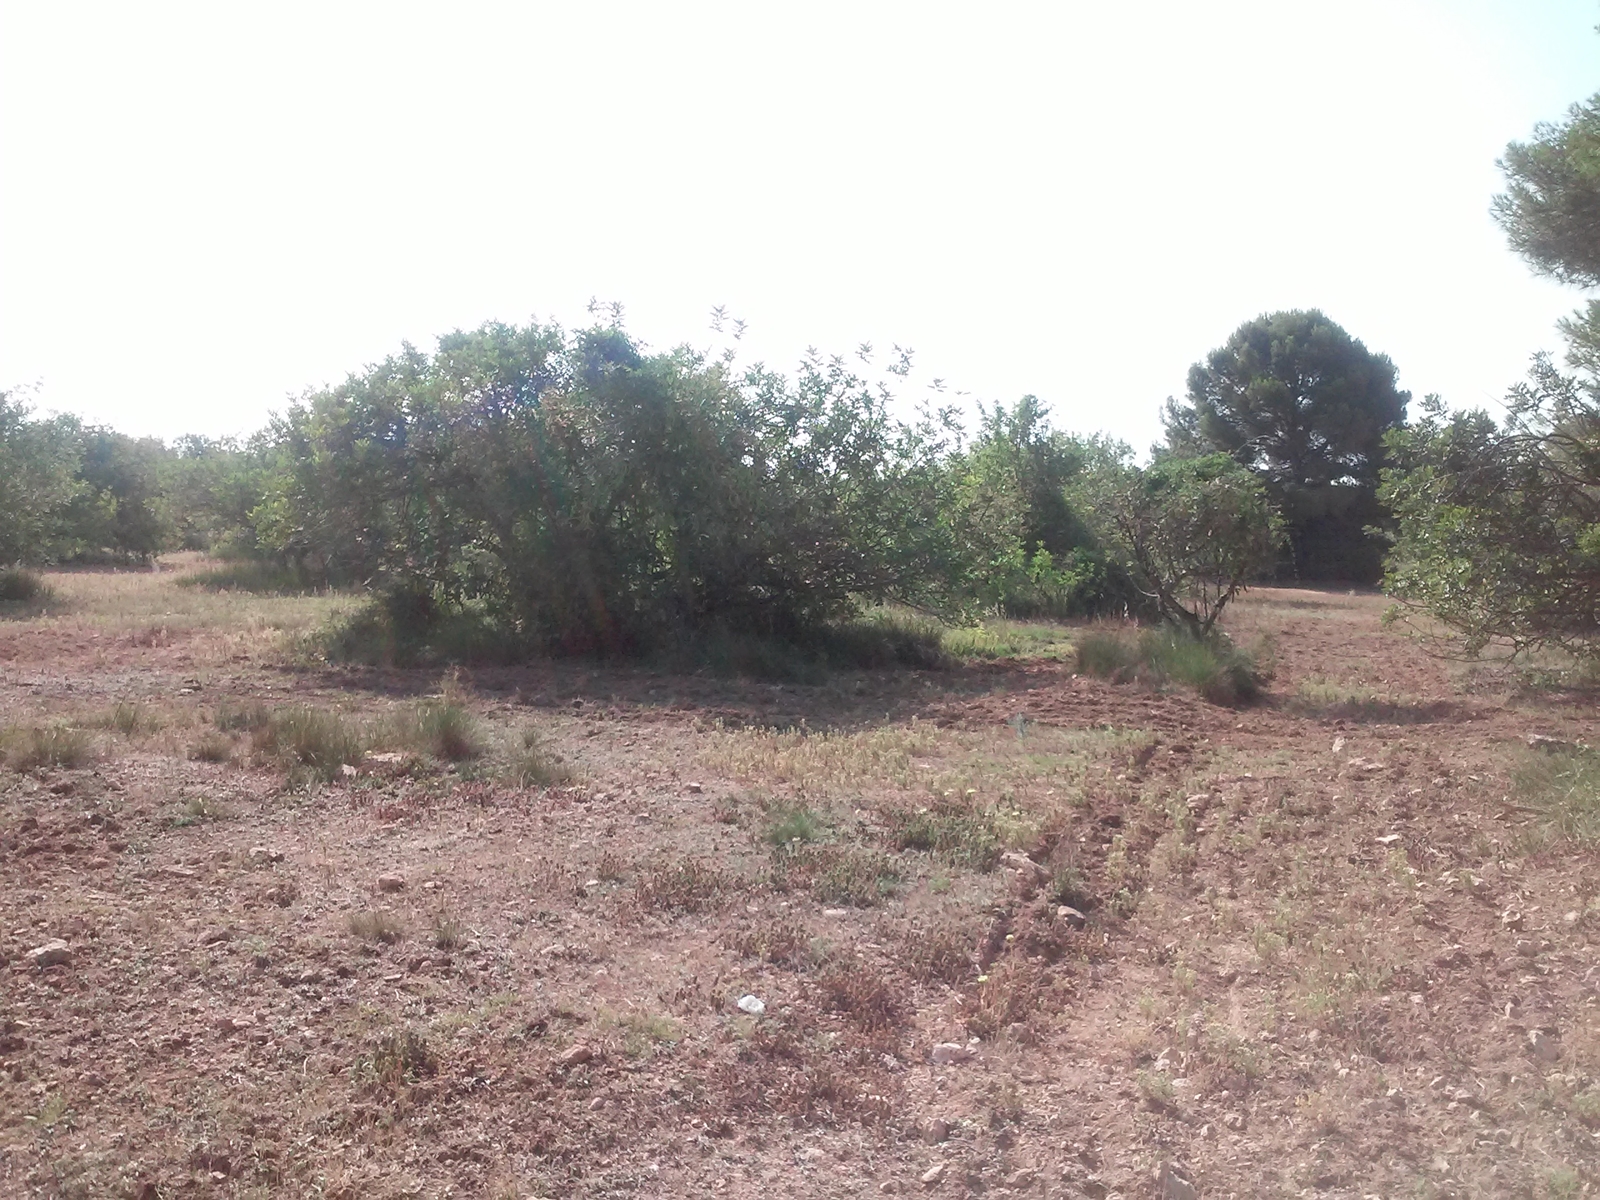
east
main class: Cropland
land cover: Permanent industrial crops
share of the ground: 10 - 25 %
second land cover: Other bare soil
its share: > 75 %
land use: Agriculture (excluding fallow land and kitchen gardens)
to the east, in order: Permanent industrial crops; Other bare soil; Grass margins; Permanent industrial crops
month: July
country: ES
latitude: 41.2212
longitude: 1.2496
